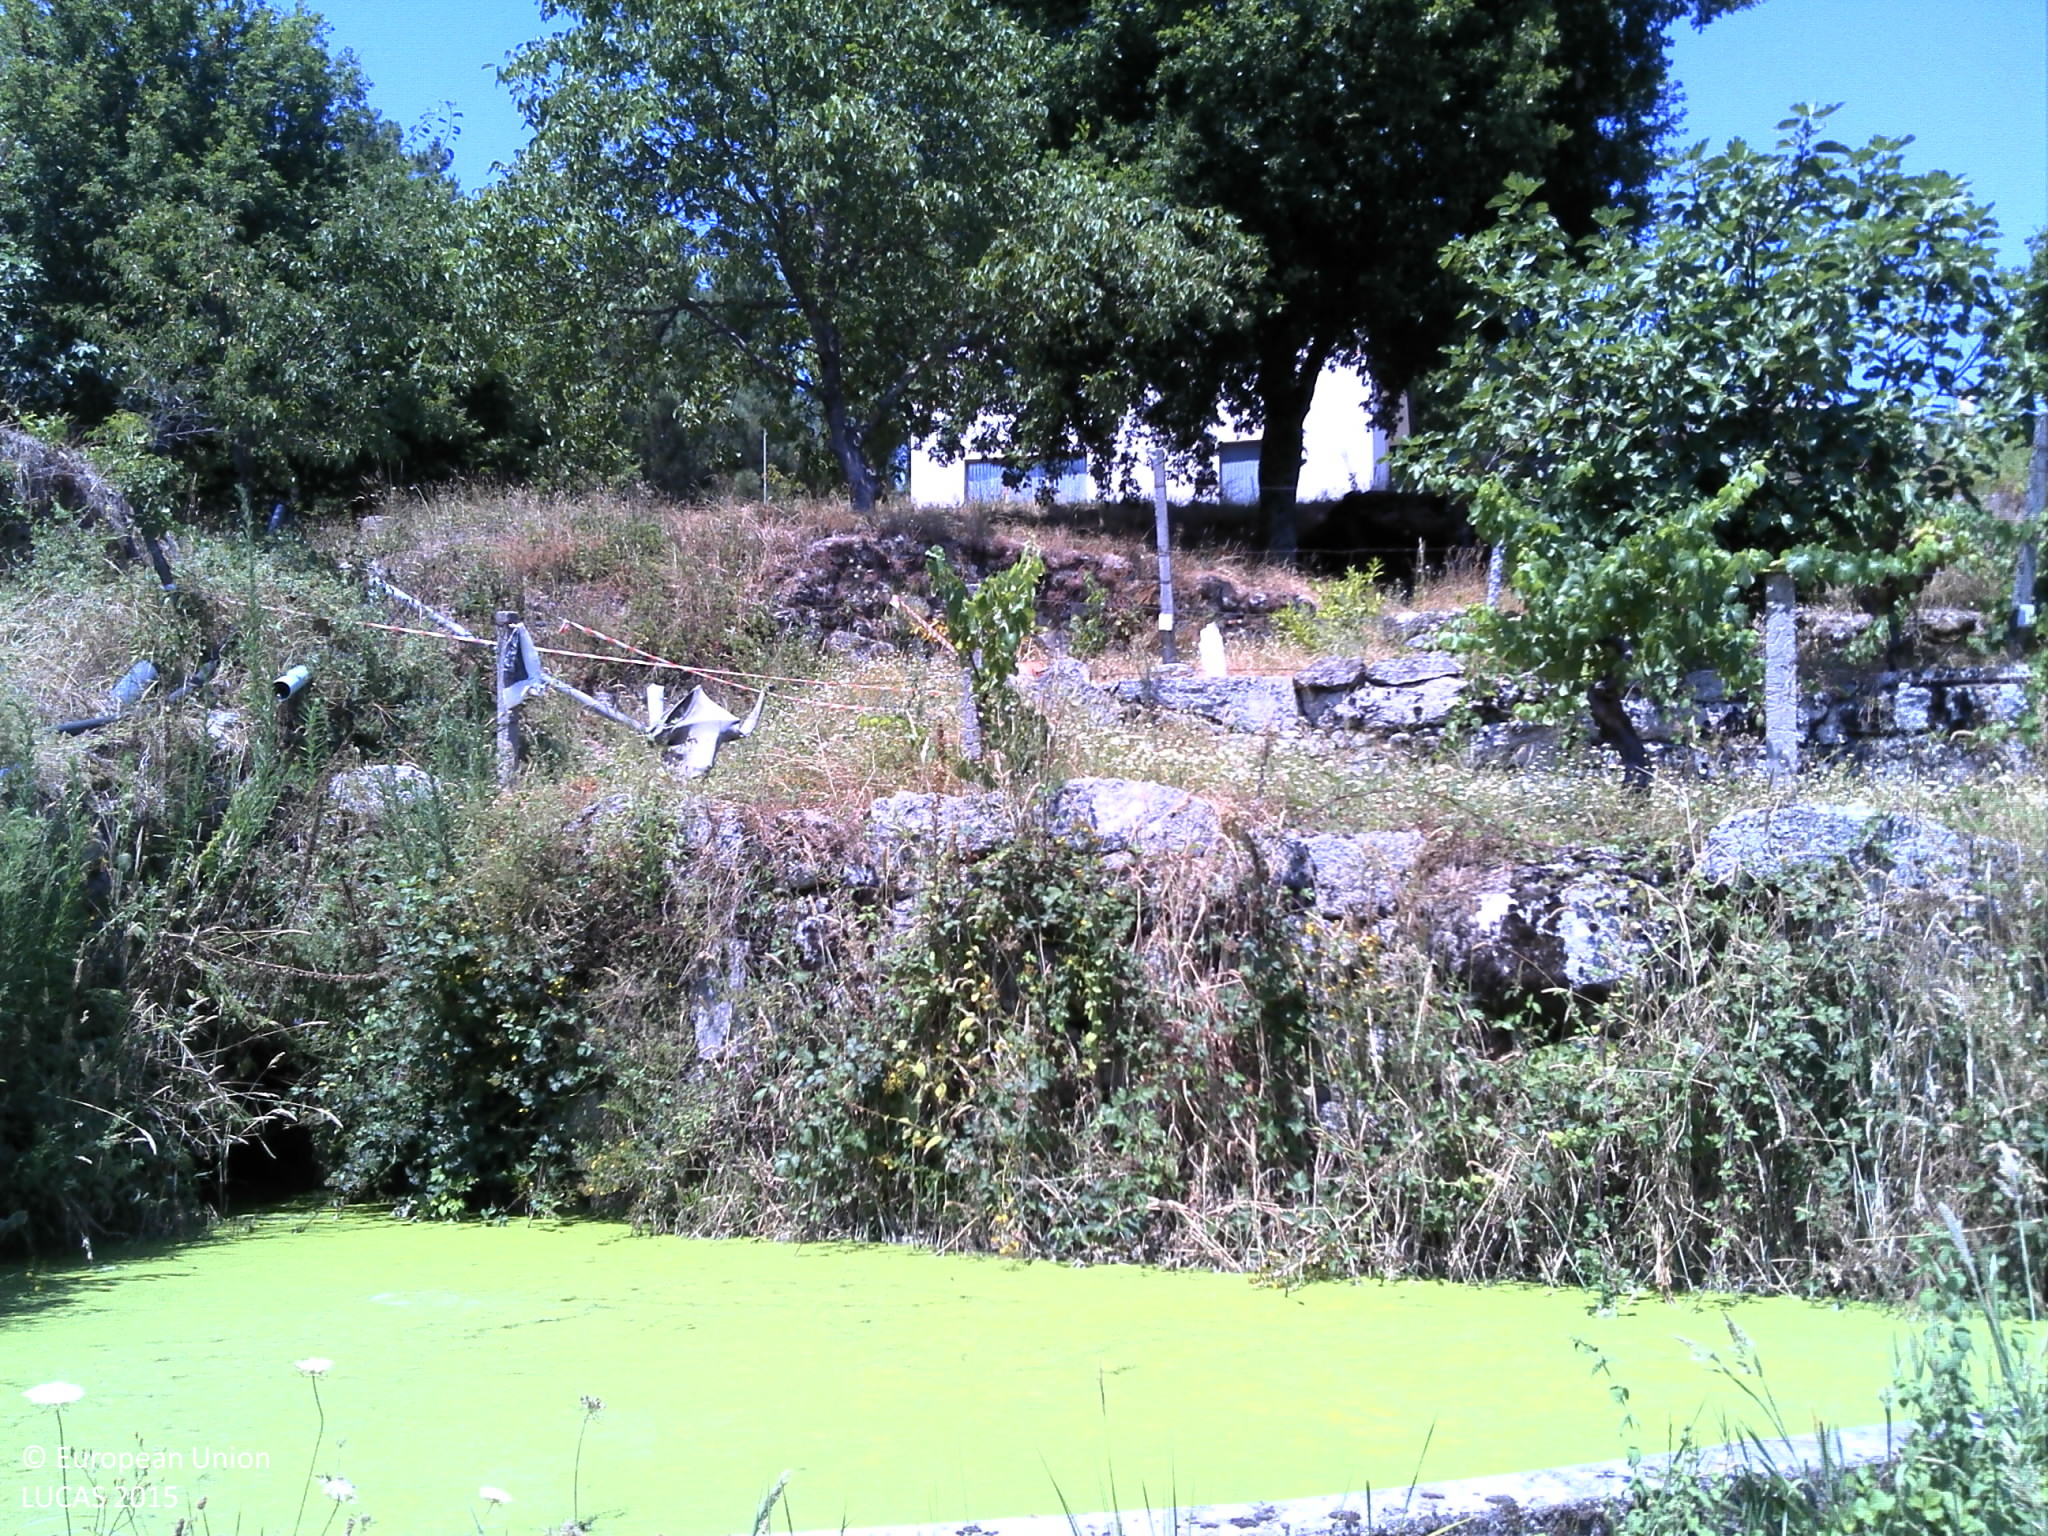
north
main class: Grassland
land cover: Grassland without tree/shrub cover
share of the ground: > 75 %
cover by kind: herbaceous plants 100 %
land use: Agriculture (excluding fallow land and kitchen gardens)
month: July
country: PT
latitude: 40.8618
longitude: -7.8872
